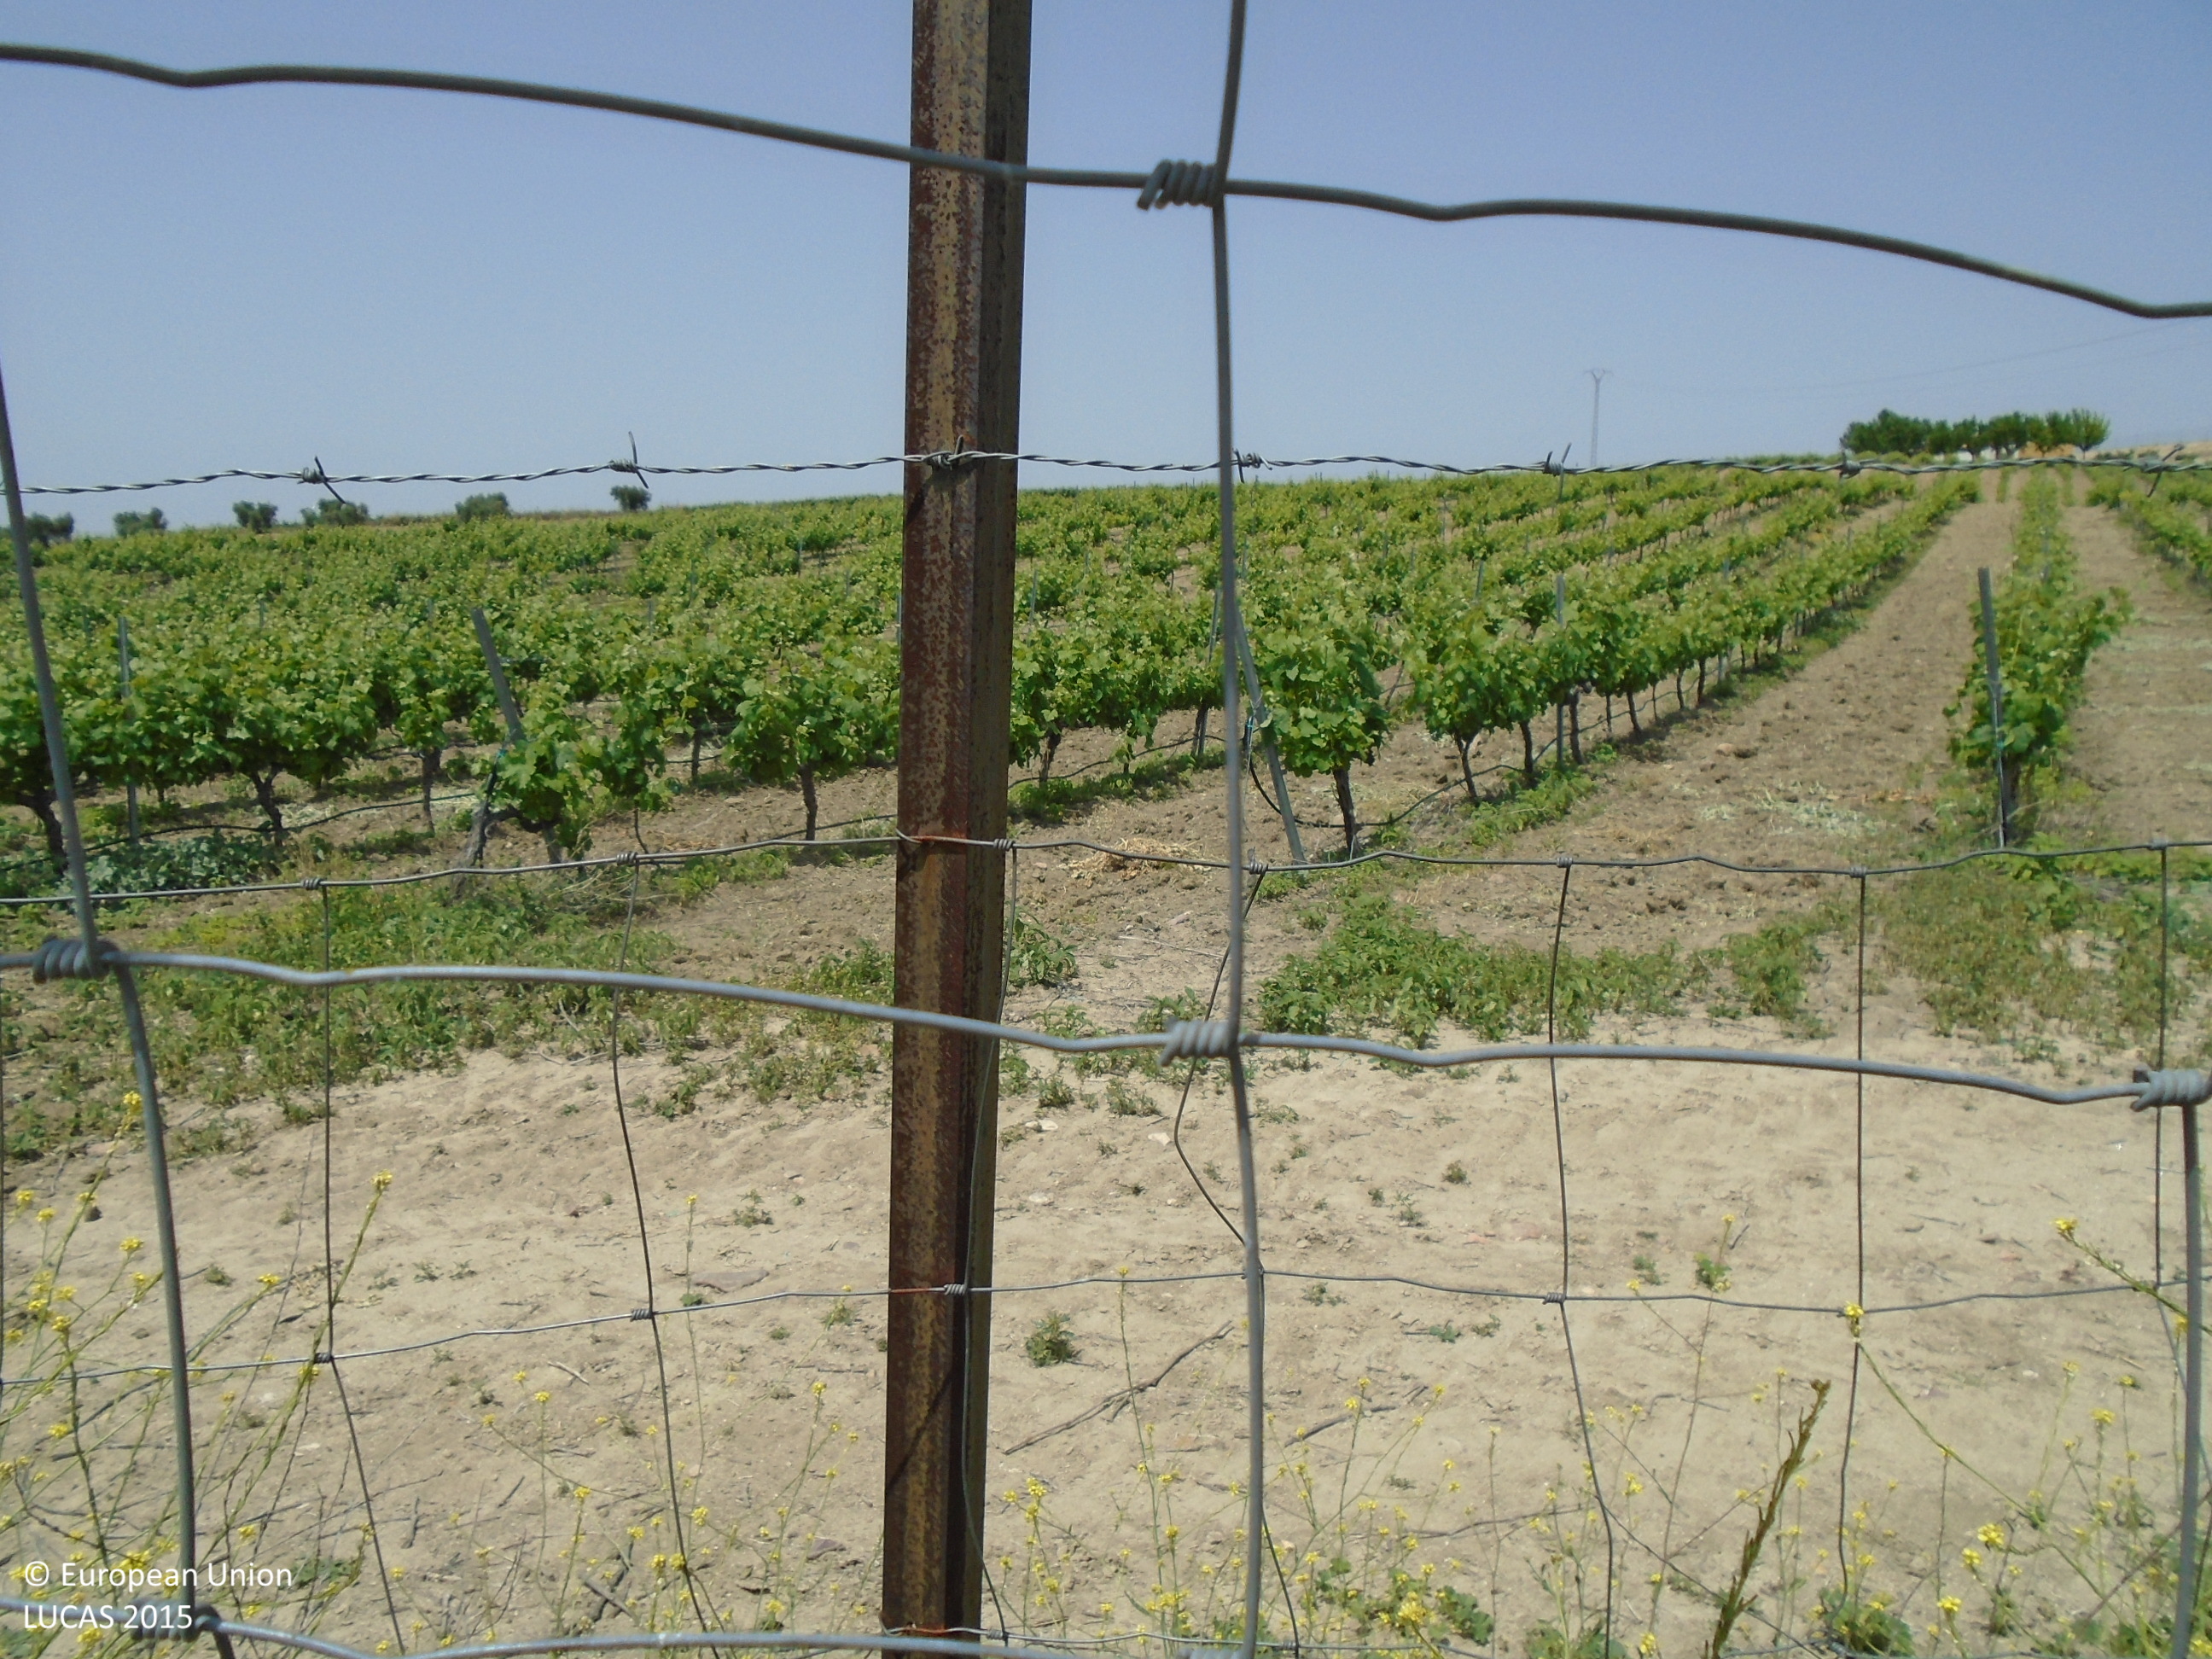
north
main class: Cropland
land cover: Vineyards
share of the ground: 10 - 25 %
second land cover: Other bare soil
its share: > 75 %
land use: Agriculture (excluding fallow land and kitchen gardens)
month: May
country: ES
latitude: 39.7885
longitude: -4.6270
